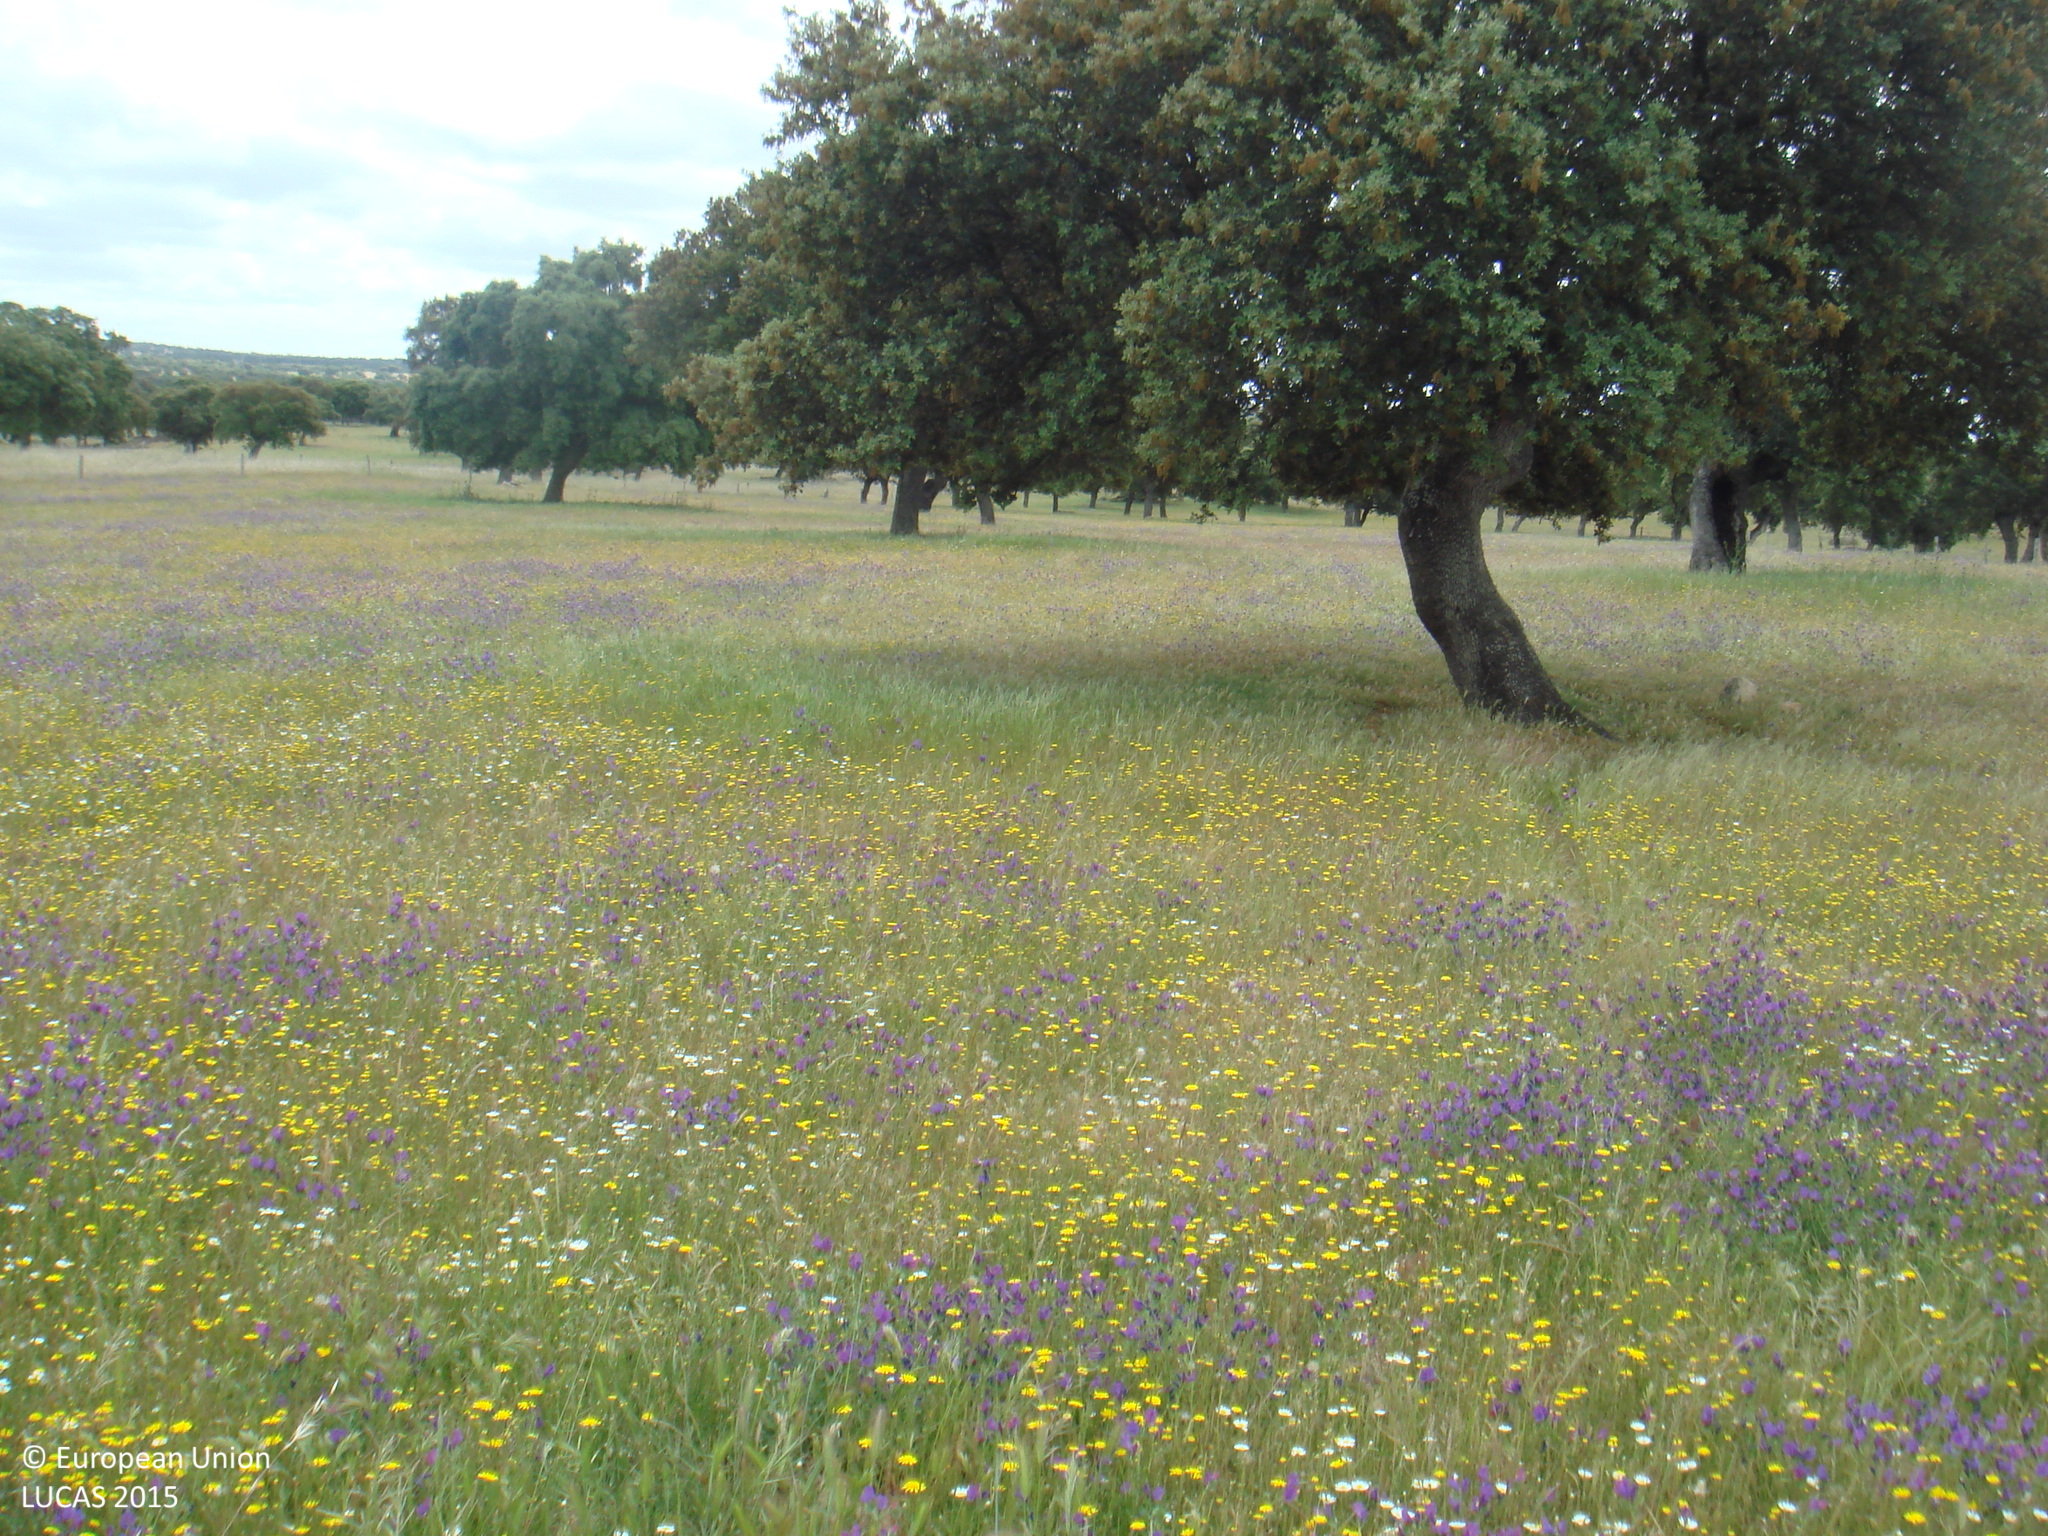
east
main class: Woodland
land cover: Broadleaved woodland
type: broadleaved evergreen forest
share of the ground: 10 - 25 %
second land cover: Spontaneously vegetated surfaces
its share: > 75 %
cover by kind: herbaceous plants 70 %, shrubs 20 %, broadleaved forest trees 10 %
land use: Forestry
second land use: Agriculture (excluding fallow land and kitchen gardens)
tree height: > 5 m
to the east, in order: Broadleaved woodland; Spontaneously vegetated surfaces; Fences; Broadleaved woodland; Fences; Spontaneously vegetated surfaces; Fences; Broadleaved woodland; Fences; Broadleaved woodland; Rock outcrops; Spontaneously vegetated surfaces; Fences; Spontaneously vegetated surfaces; Broadleaved woodland
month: May
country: ES
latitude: 38.4729
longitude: -4.7059
